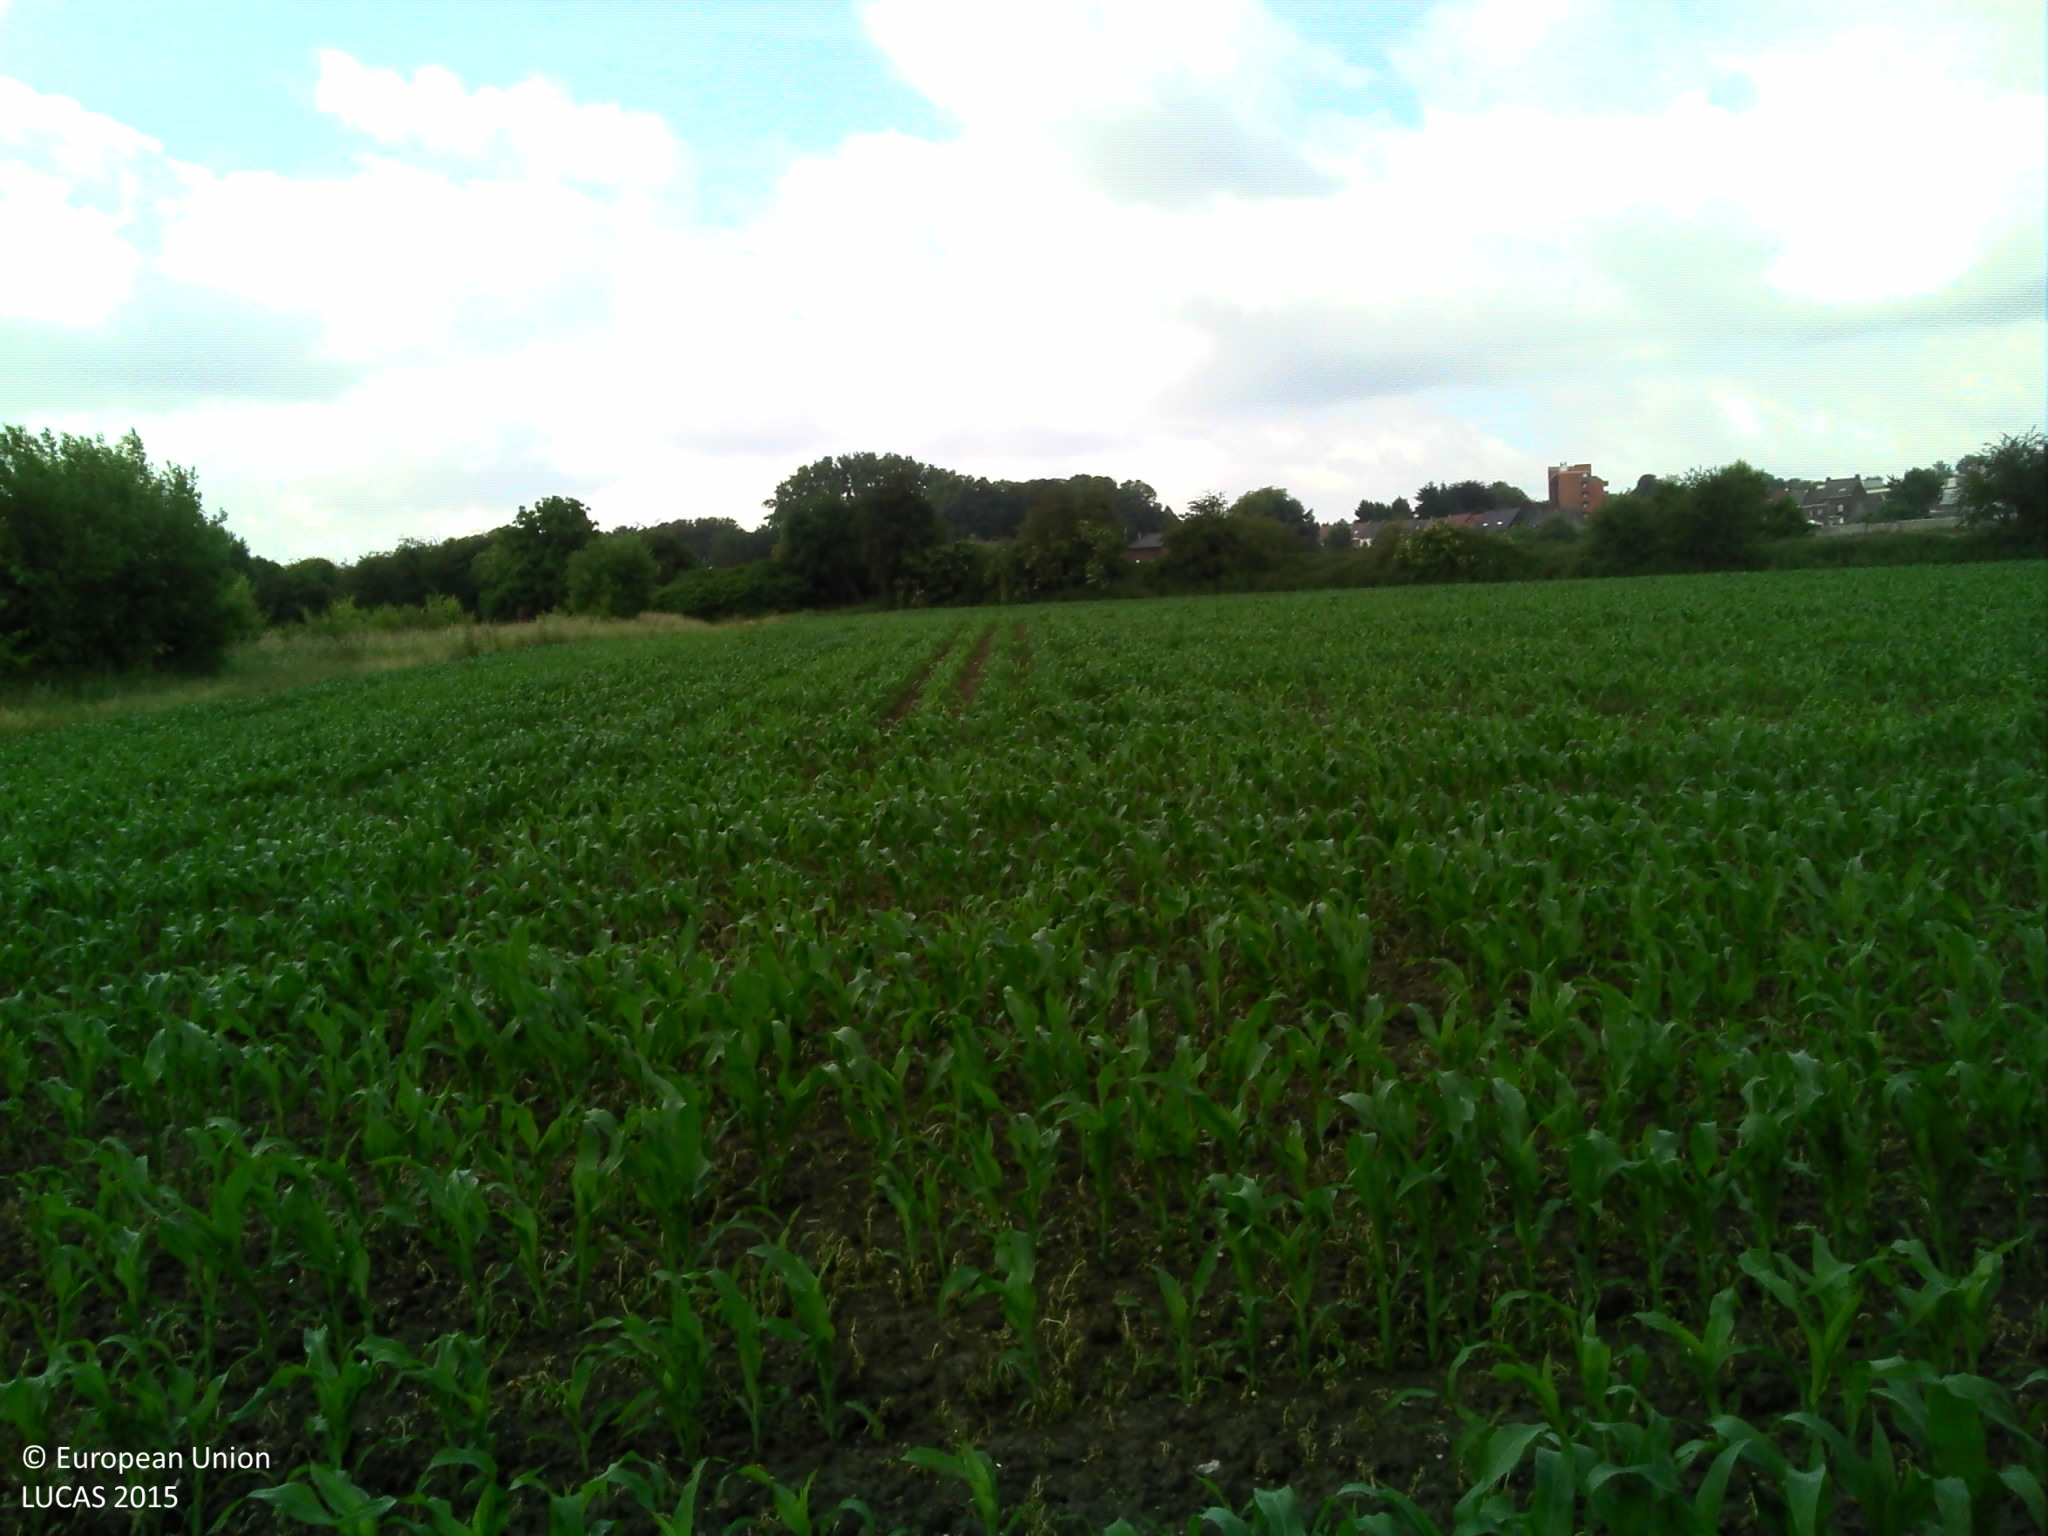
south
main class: Cropland
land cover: Maize
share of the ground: 25 - 50 %
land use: Agriculture (excluding fallow land and kitchen gardens)
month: June
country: BE
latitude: 50.4177
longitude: 3.8999
